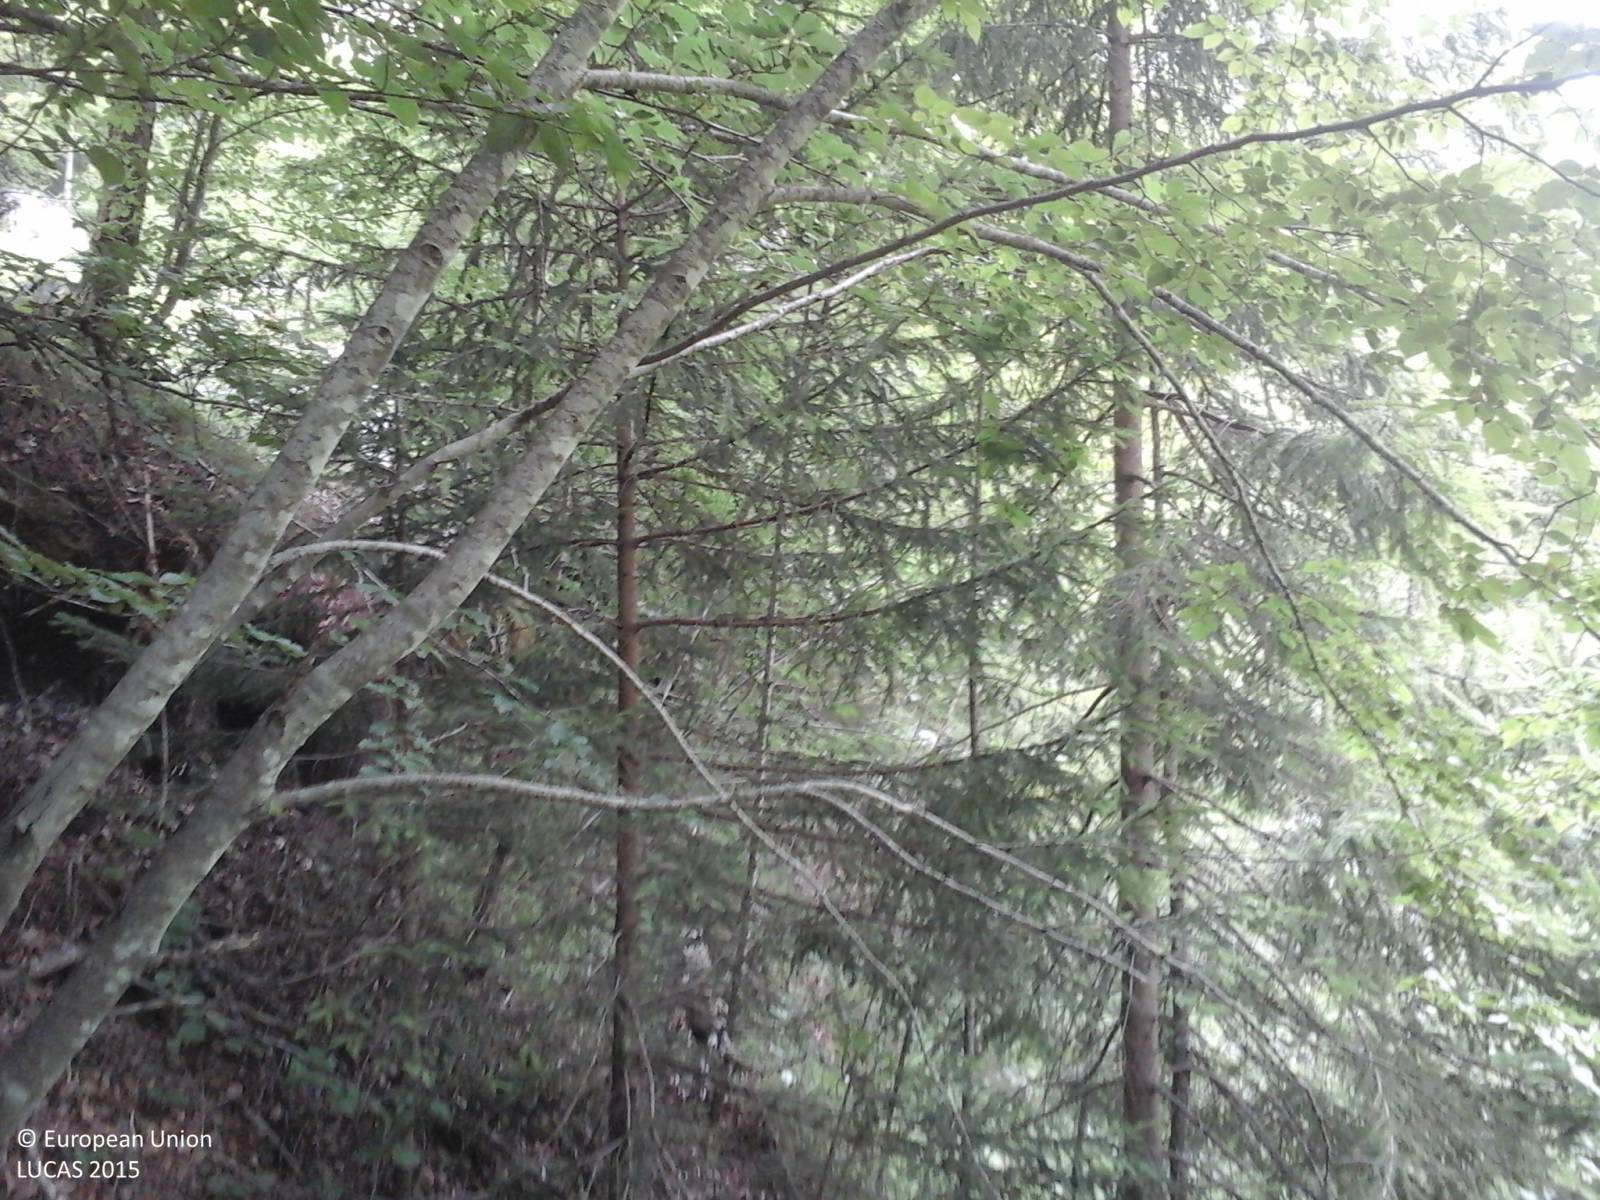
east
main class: Woodland
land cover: Broadleaved woodland
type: mountainous beech forest
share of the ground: > 75 %
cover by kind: broadleaved forest trees 75 %, coniferous forest trees 25 %
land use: Forestry
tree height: > 5 m
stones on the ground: > 50 %
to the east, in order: Broadleaved woodland; Tracks; Other coniferous woodland; Other mixed woodland
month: July
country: IT
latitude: 46.2877
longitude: 12.4244
